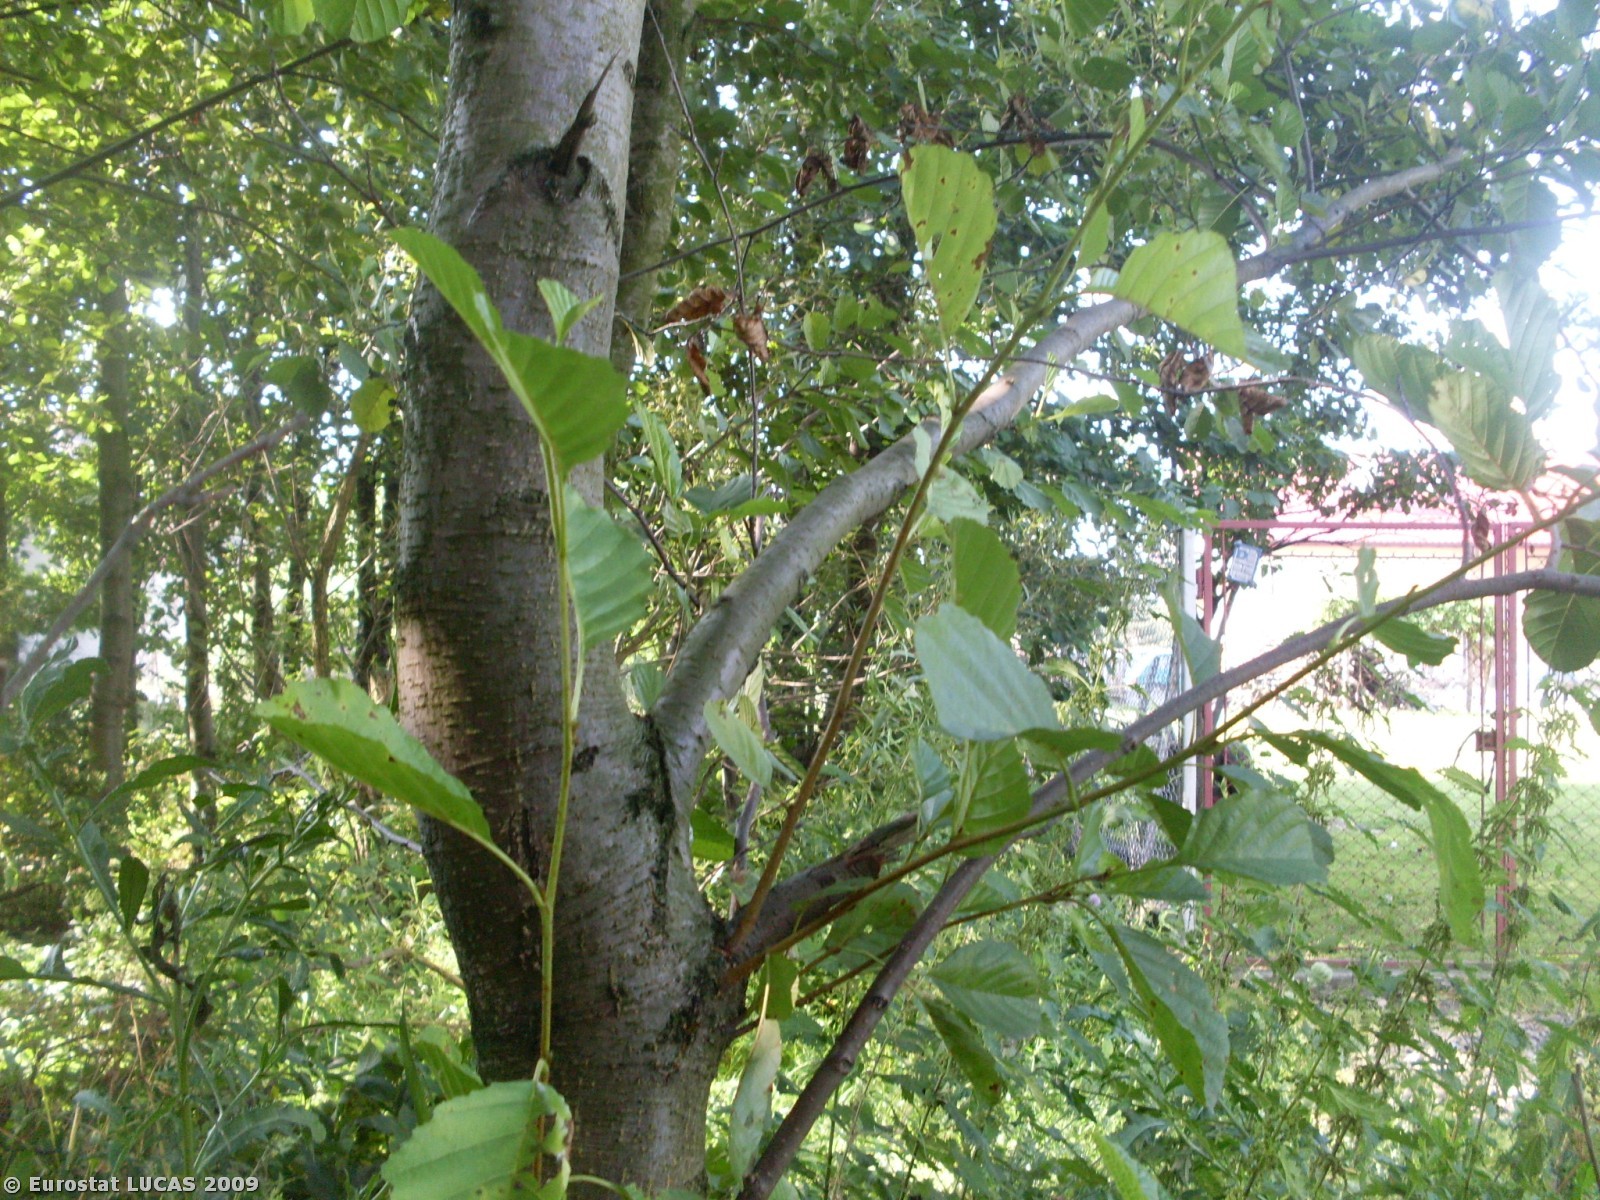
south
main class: Woodland
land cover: Broadleaved woodland
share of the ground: > 75 %
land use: Unused
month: August
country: PL
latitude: 49.9871
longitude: 20.5122
